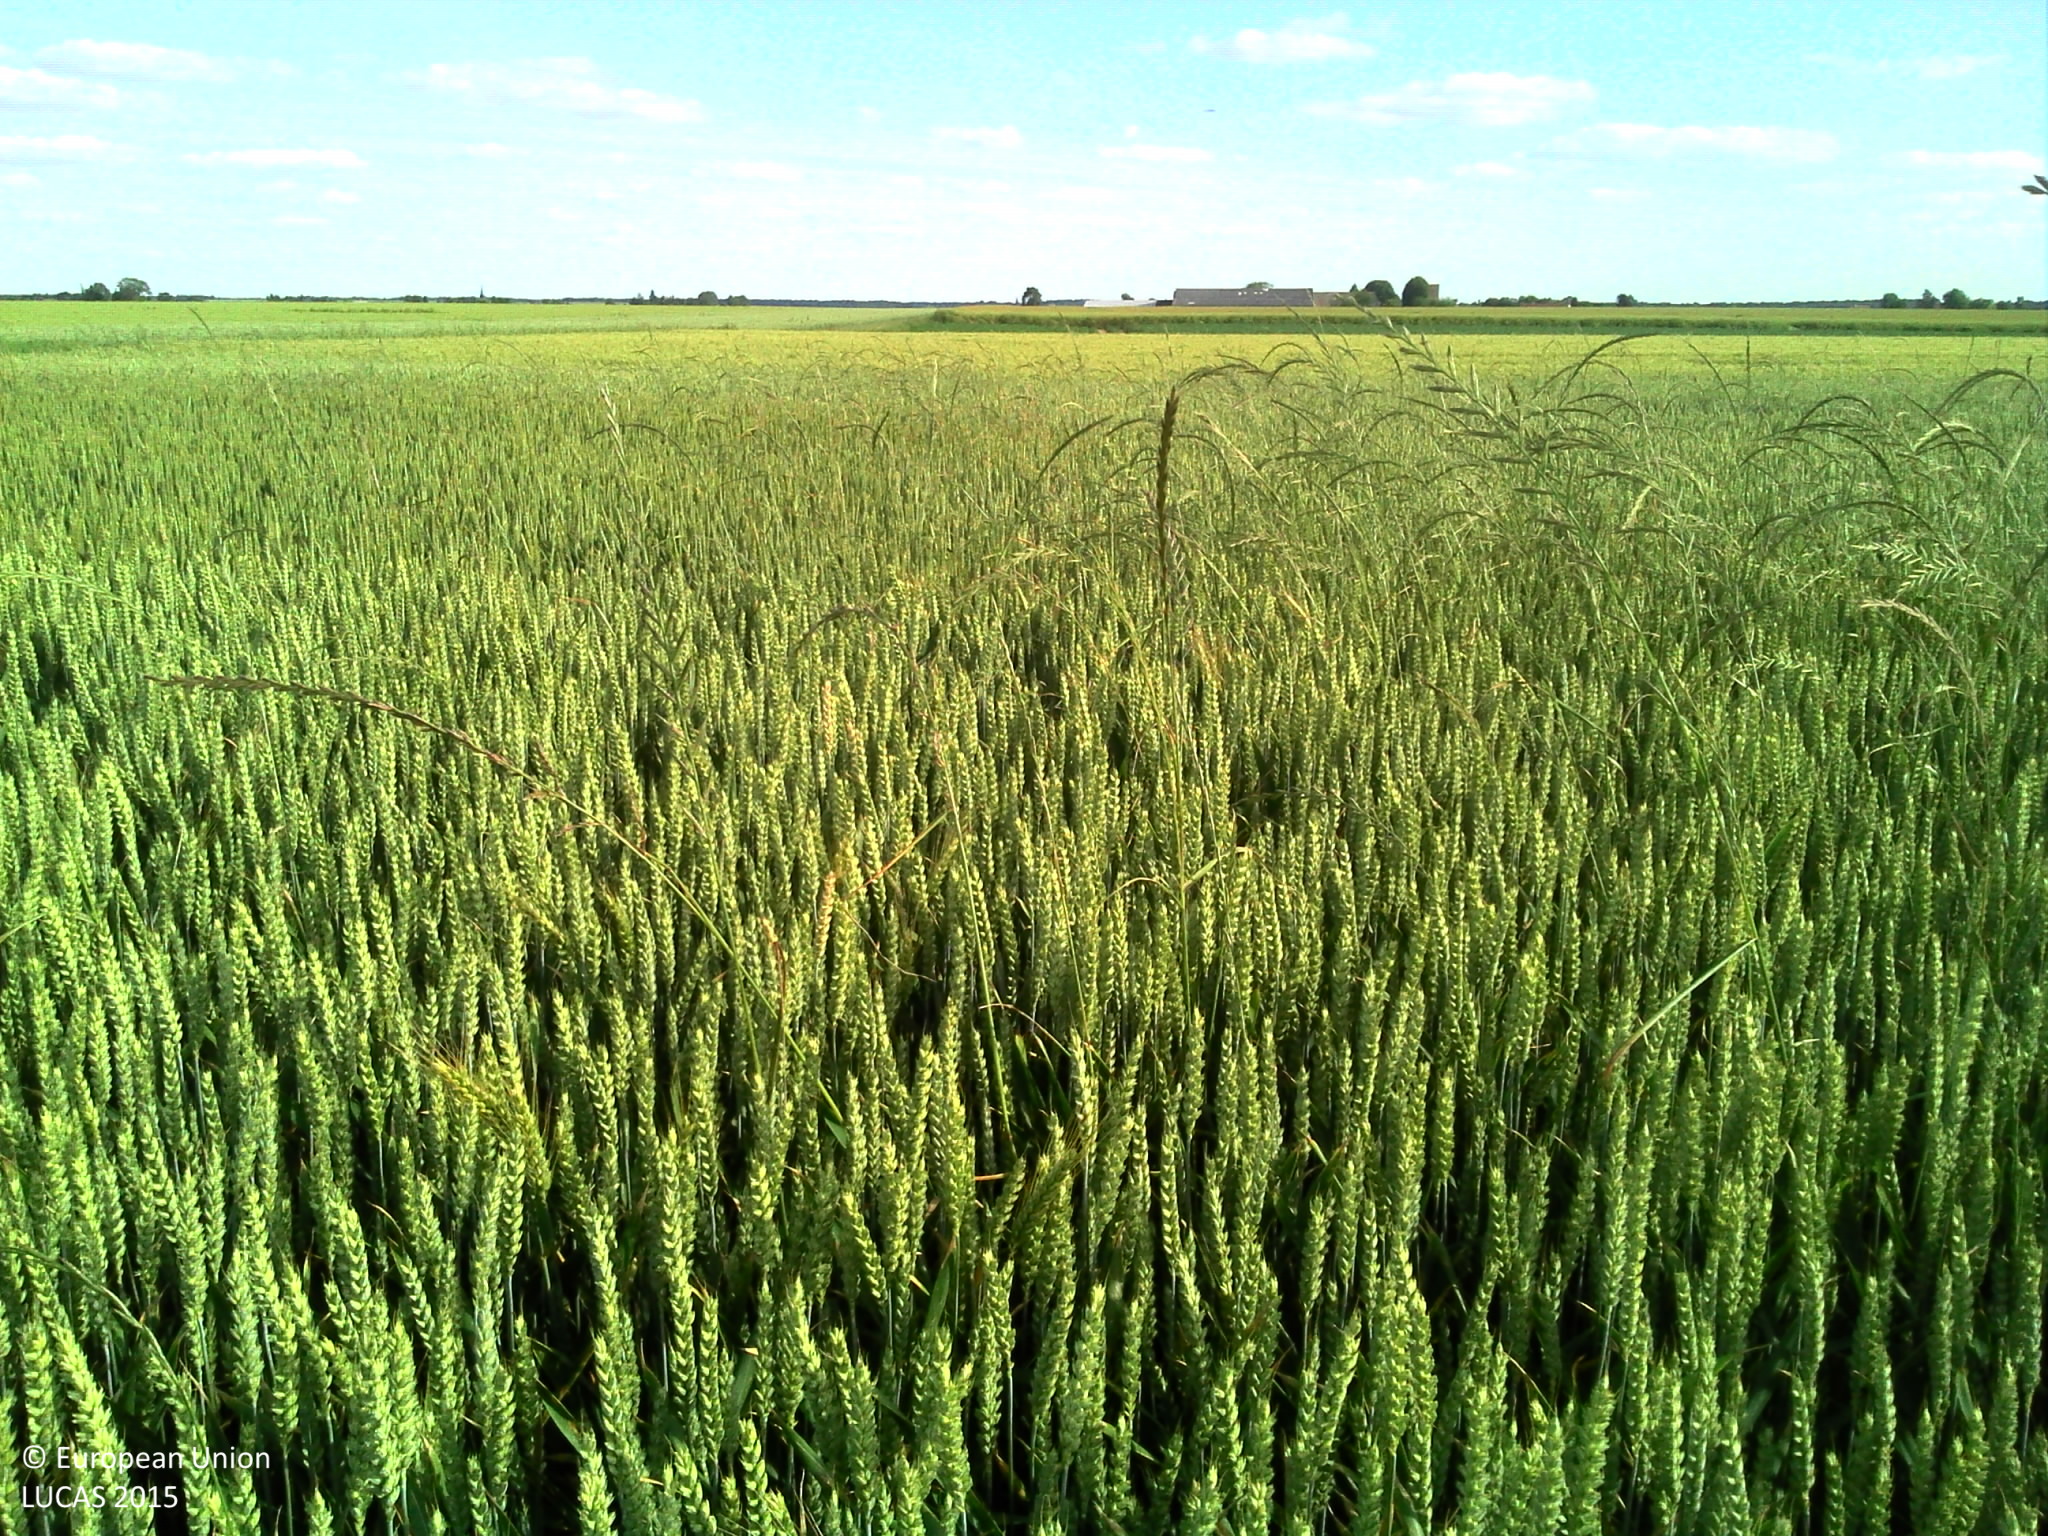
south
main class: Cropland
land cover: Common wheat
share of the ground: > 75 %
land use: Agriculture (excluding fallow land and kitchen gardens)
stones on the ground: < 10 %
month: June
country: FR
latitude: 49.2001
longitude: 1.0718
